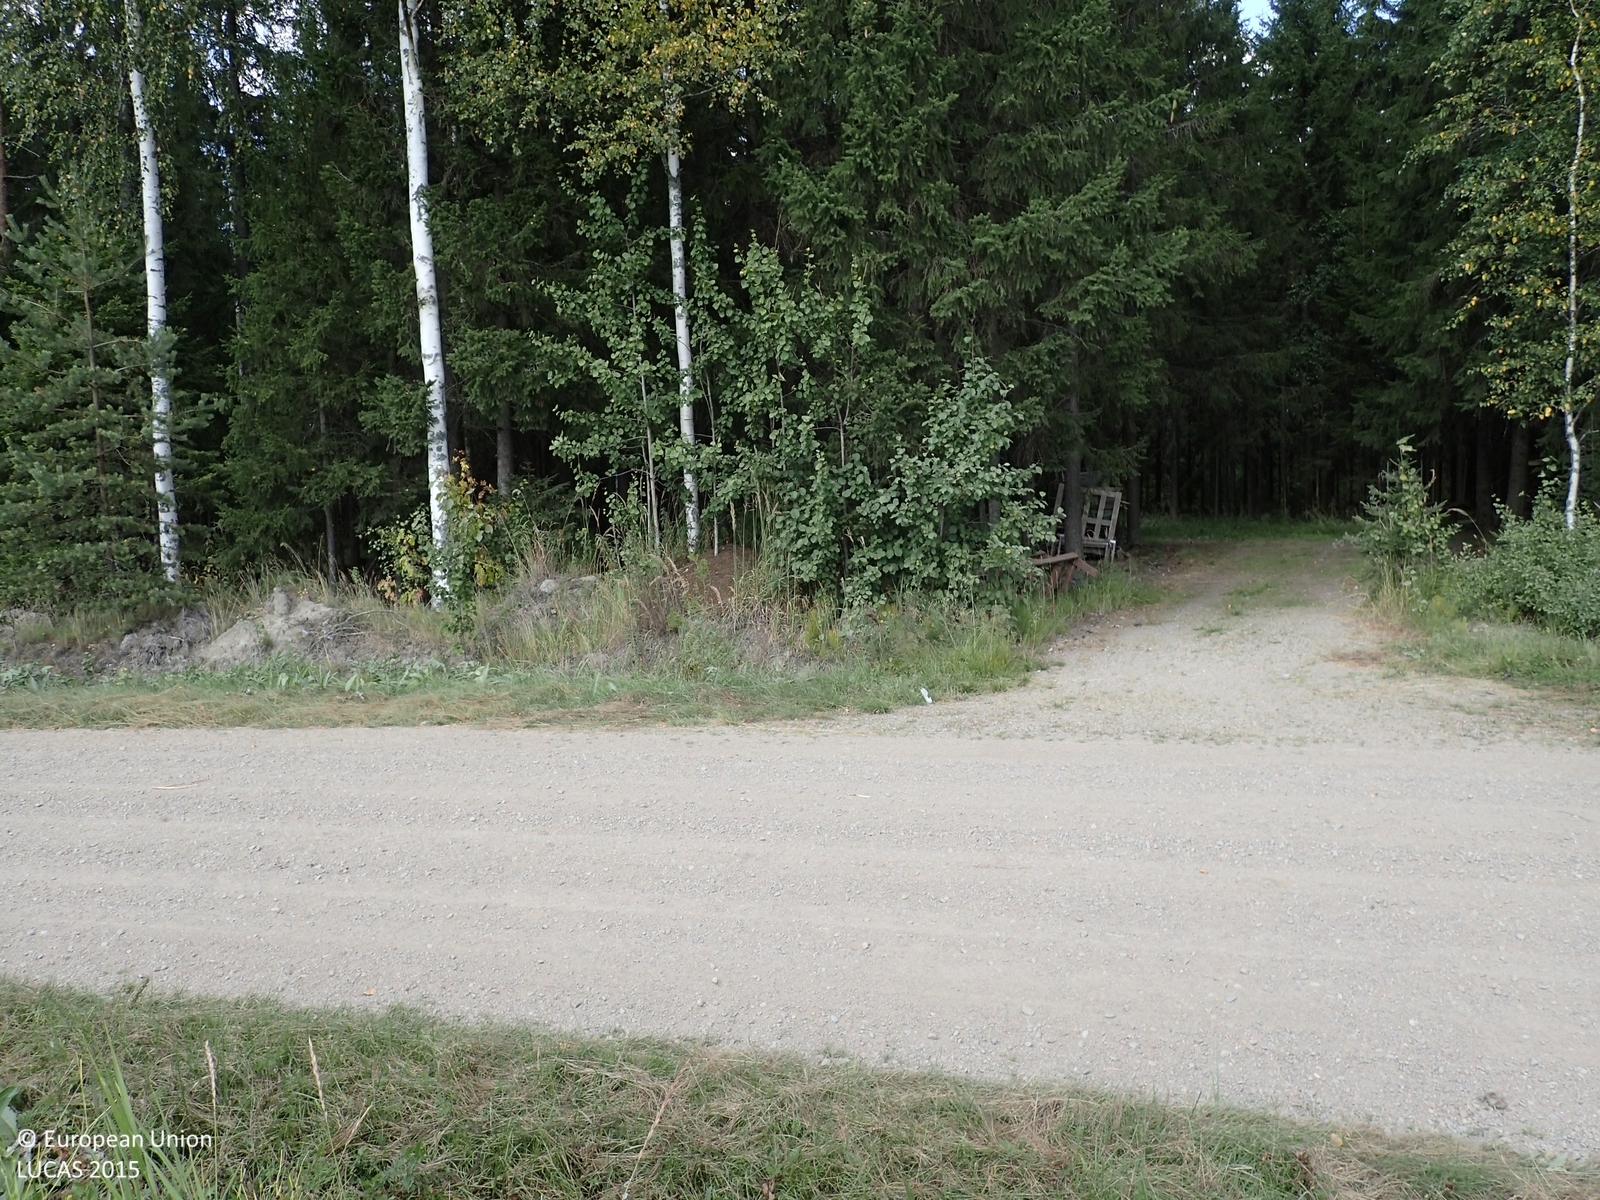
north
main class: Cropland
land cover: Rape and turnip rape
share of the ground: > 75 %
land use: Agriculture (excluding fallow land and kitchen gardens)
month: August
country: FI
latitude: 62.7010
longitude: 22.6227
